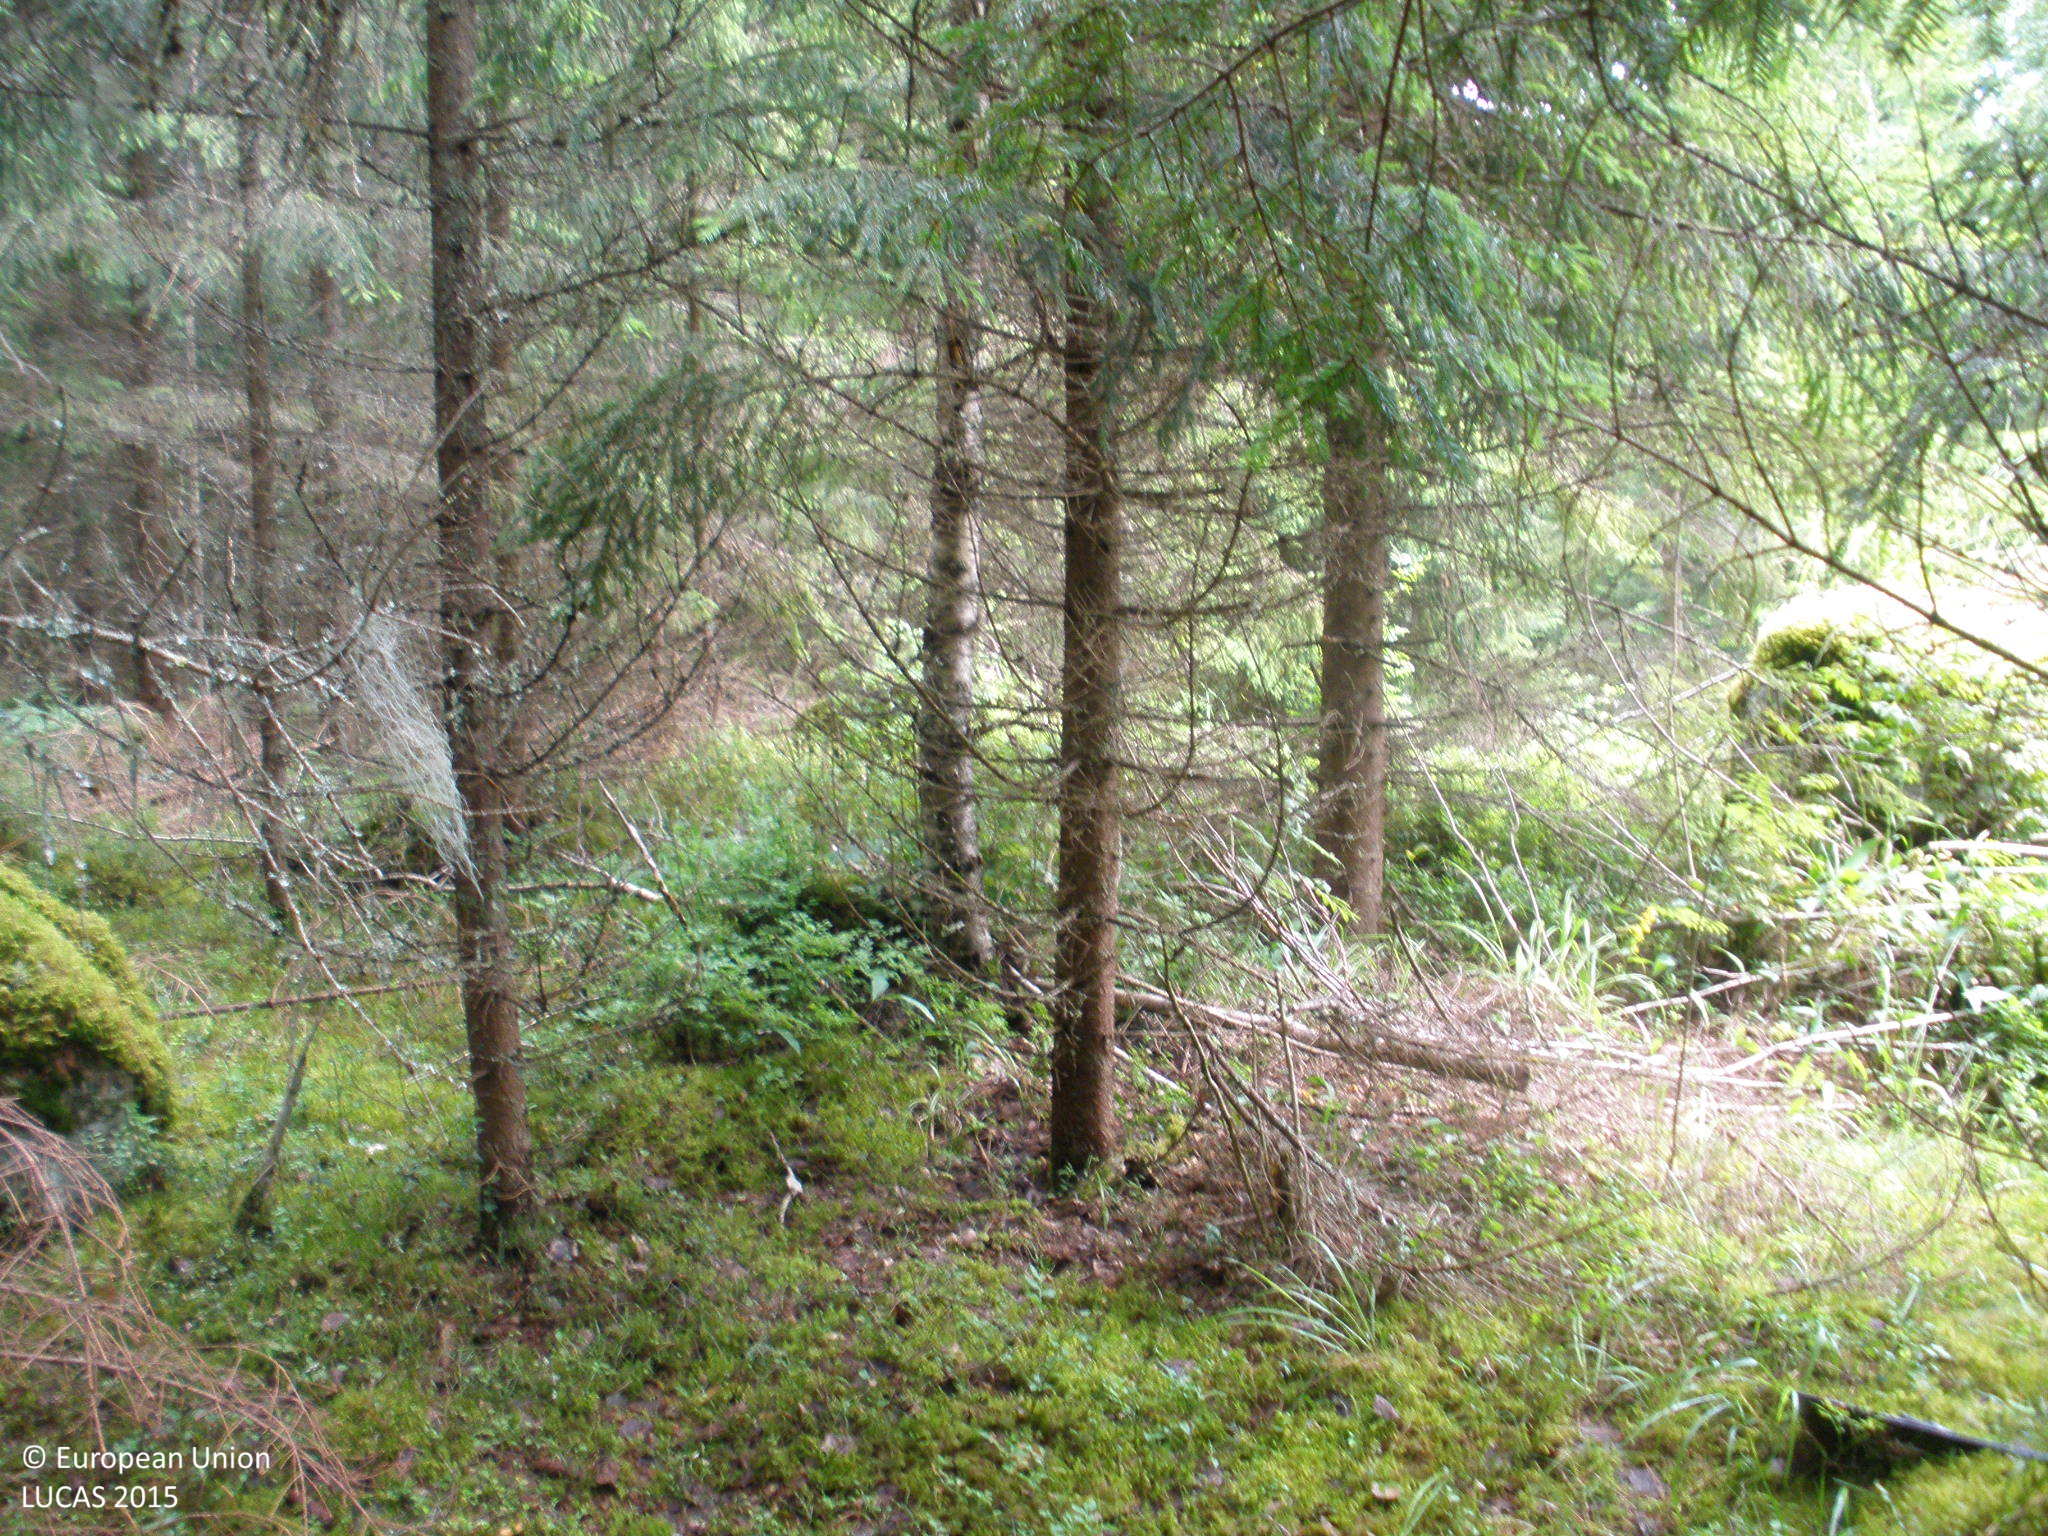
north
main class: Woodland
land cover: Spruce dominated coniferous woodland
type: boreal forest
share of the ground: > 75 %
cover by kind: coniferous forest trees 90 %, herbaceous plants 5 %, lichens and mosses 5 %
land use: Forestry
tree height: > 5 m
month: July
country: FI
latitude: 60.9475
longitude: 25.0495
